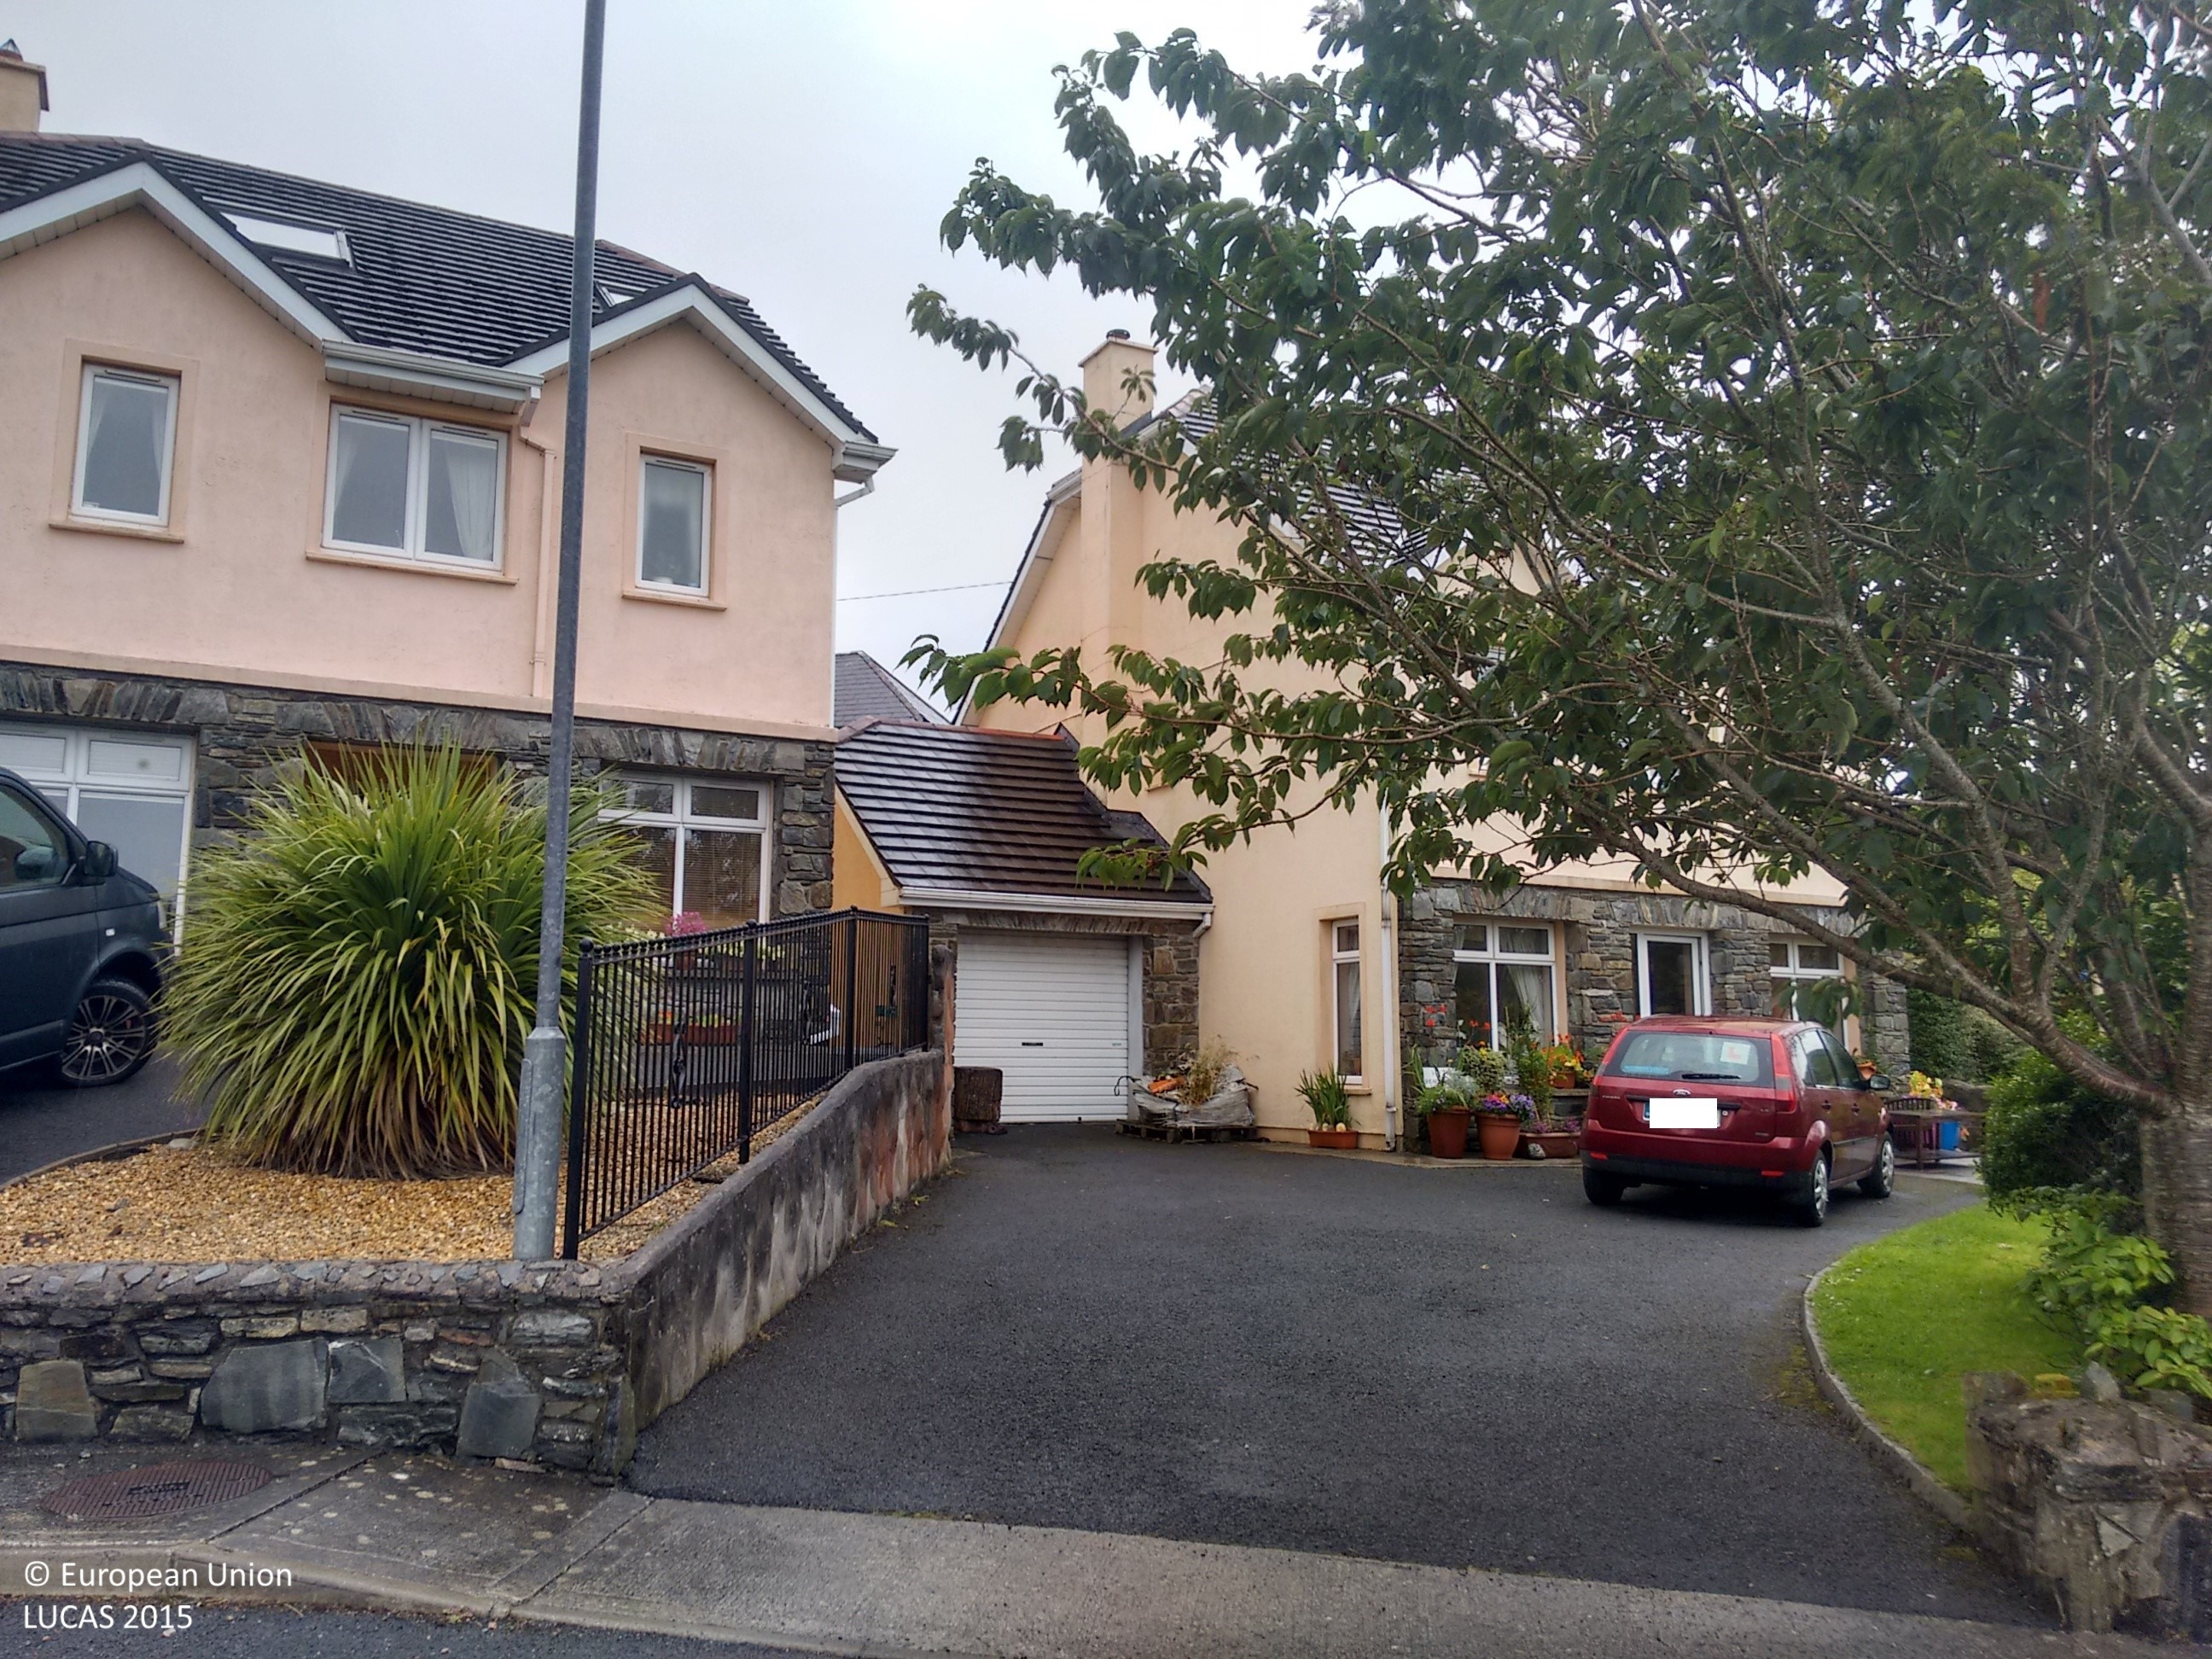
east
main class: Grassland
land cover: Grassland without tree/shrub cover
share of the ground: > 75 %
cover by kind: herbaceous plants 100 %
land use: Residential
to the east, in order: Grassland without tree/shrub cover; Artificial constructions in urban areas
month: July
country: IE
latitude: 53.4876
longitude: -10.0125
